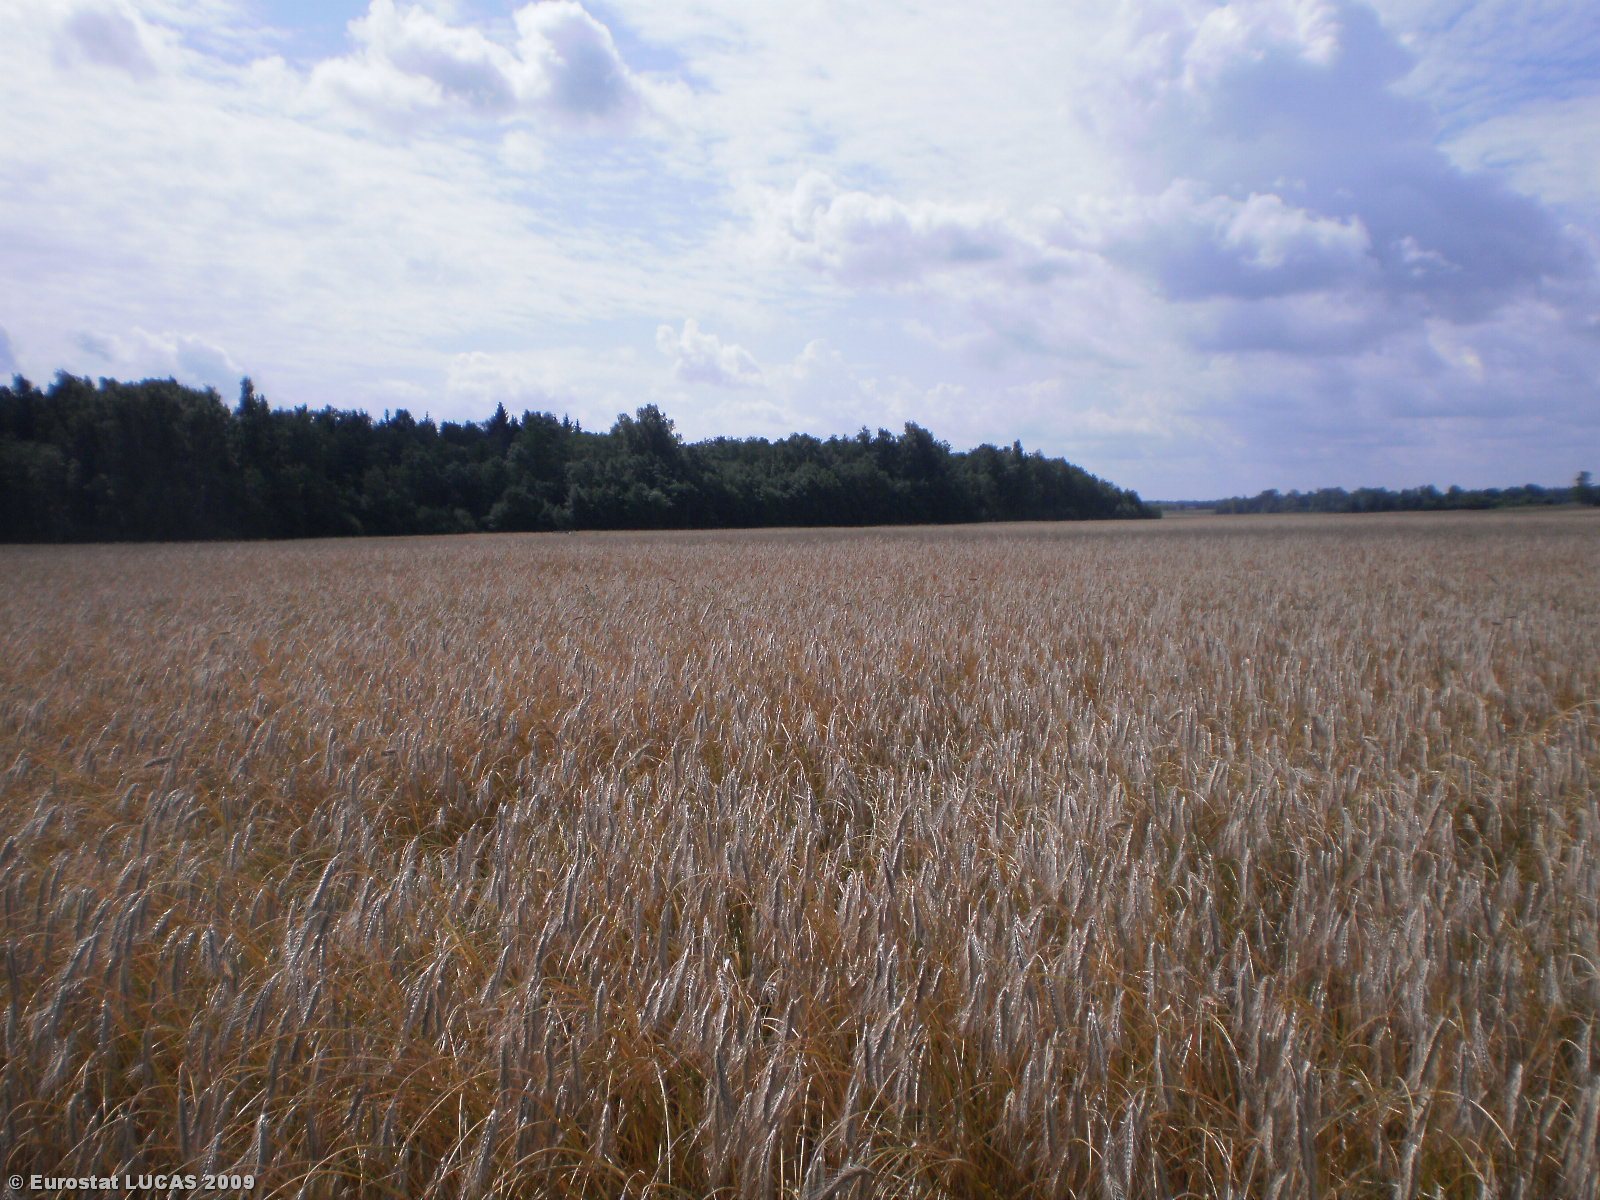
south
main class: Cropland
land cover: Rye
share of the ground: > 75 %
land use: Agriculture (excluding fallow land and kitchen gardens)
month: July
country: LT
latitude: 56.0635
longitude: 25.1958
